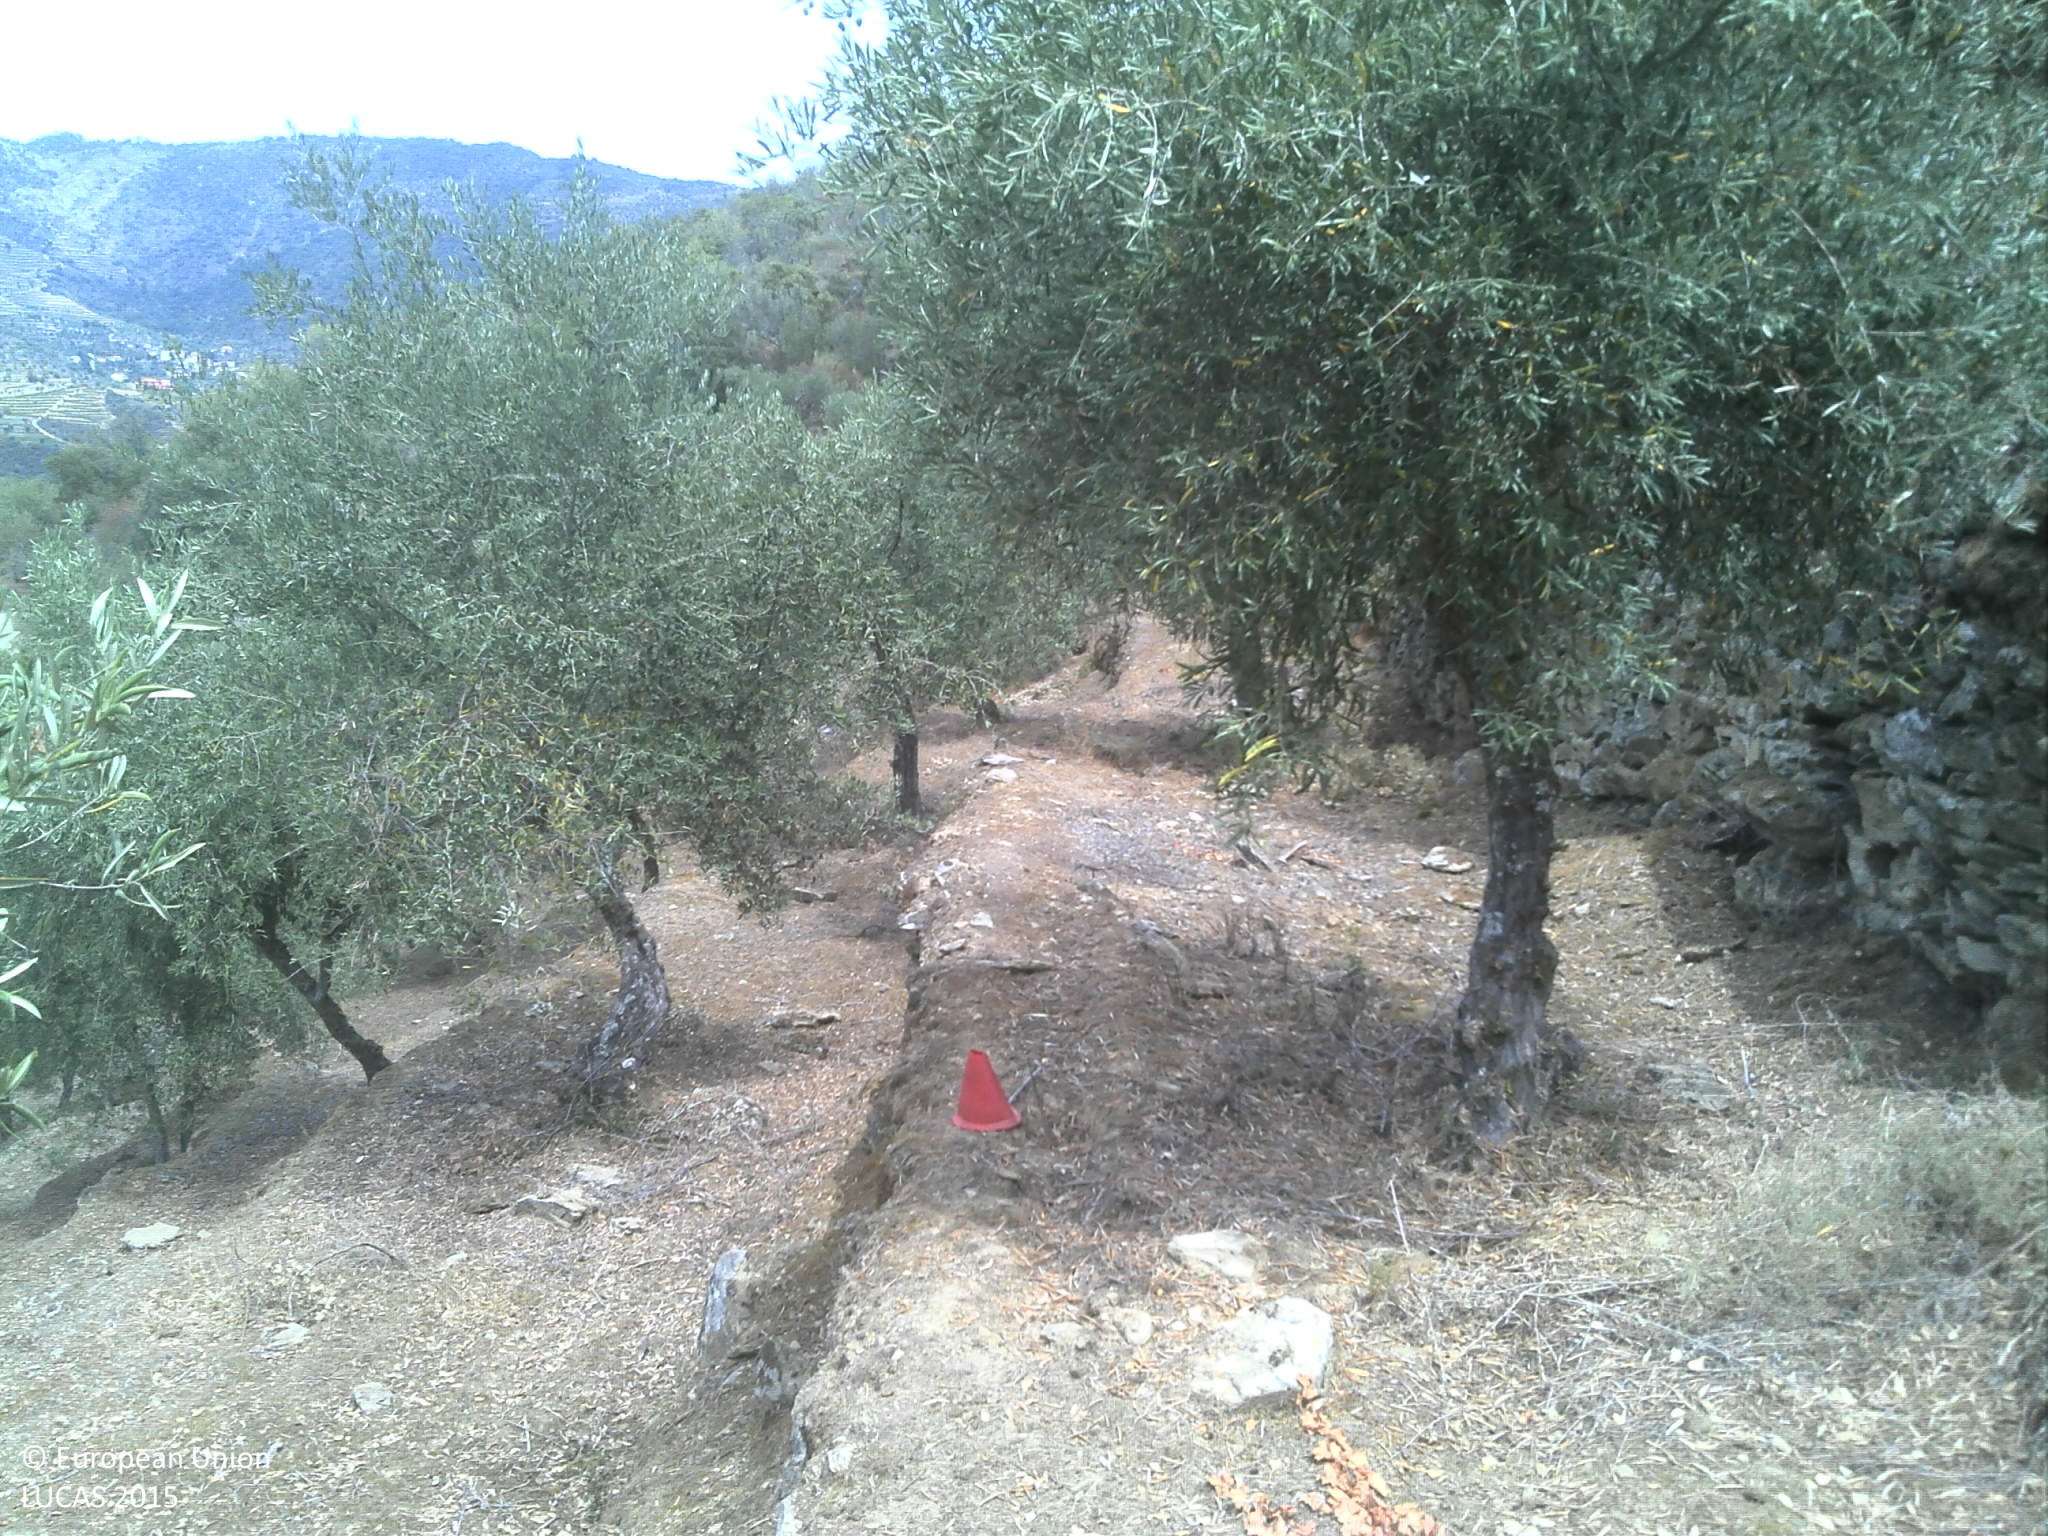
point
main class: Cropland
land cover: Olive groves
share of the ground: 25 - 50 %
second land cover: Other bare soil
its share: > 75 %
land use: Agriculture (excluding fallow land and kitchen gardens)
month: July
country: PT
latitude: 41.1407
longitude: -7.2595
